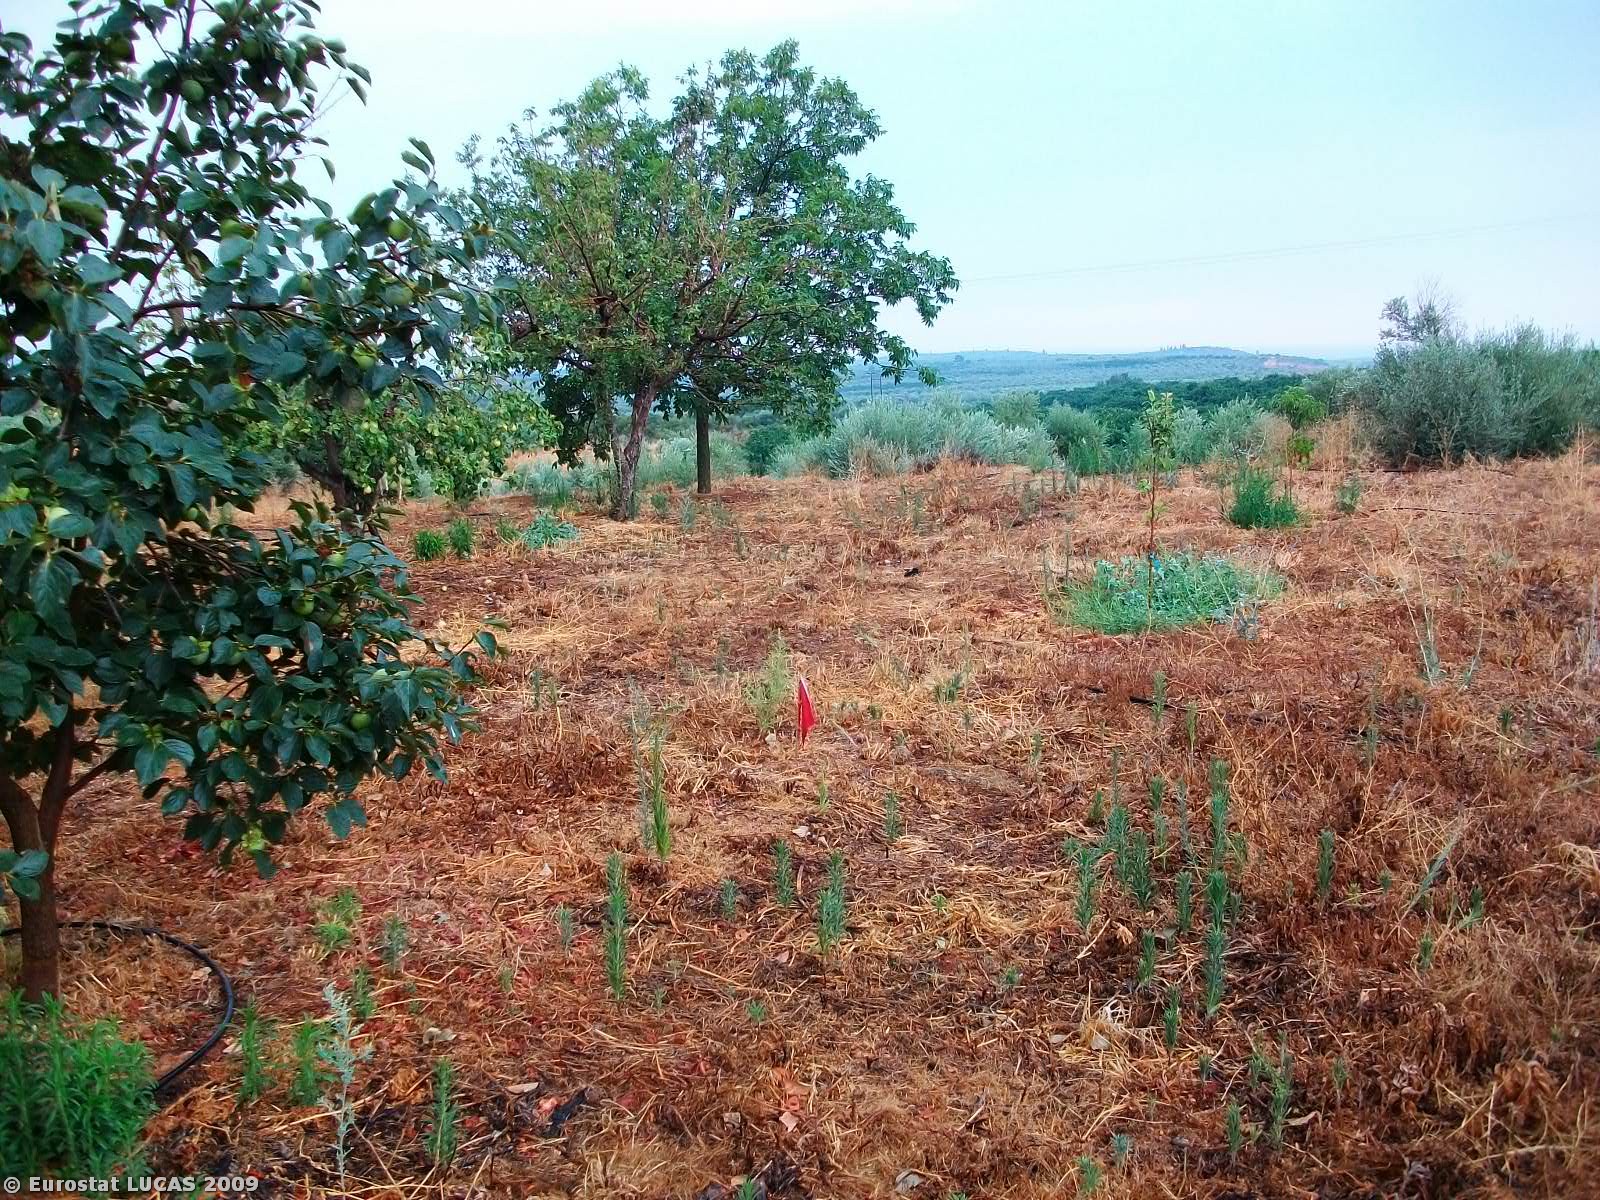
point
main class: Cropland
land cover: Pear fruit
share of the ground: 10 - 25 %
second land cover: Grassland with sparse tree/shrub cover
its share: > 75 %
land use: Agriculture (excluding fallow land and kitchen gardens)
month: August
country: GR
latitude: 36.9054
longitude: 22.7386
